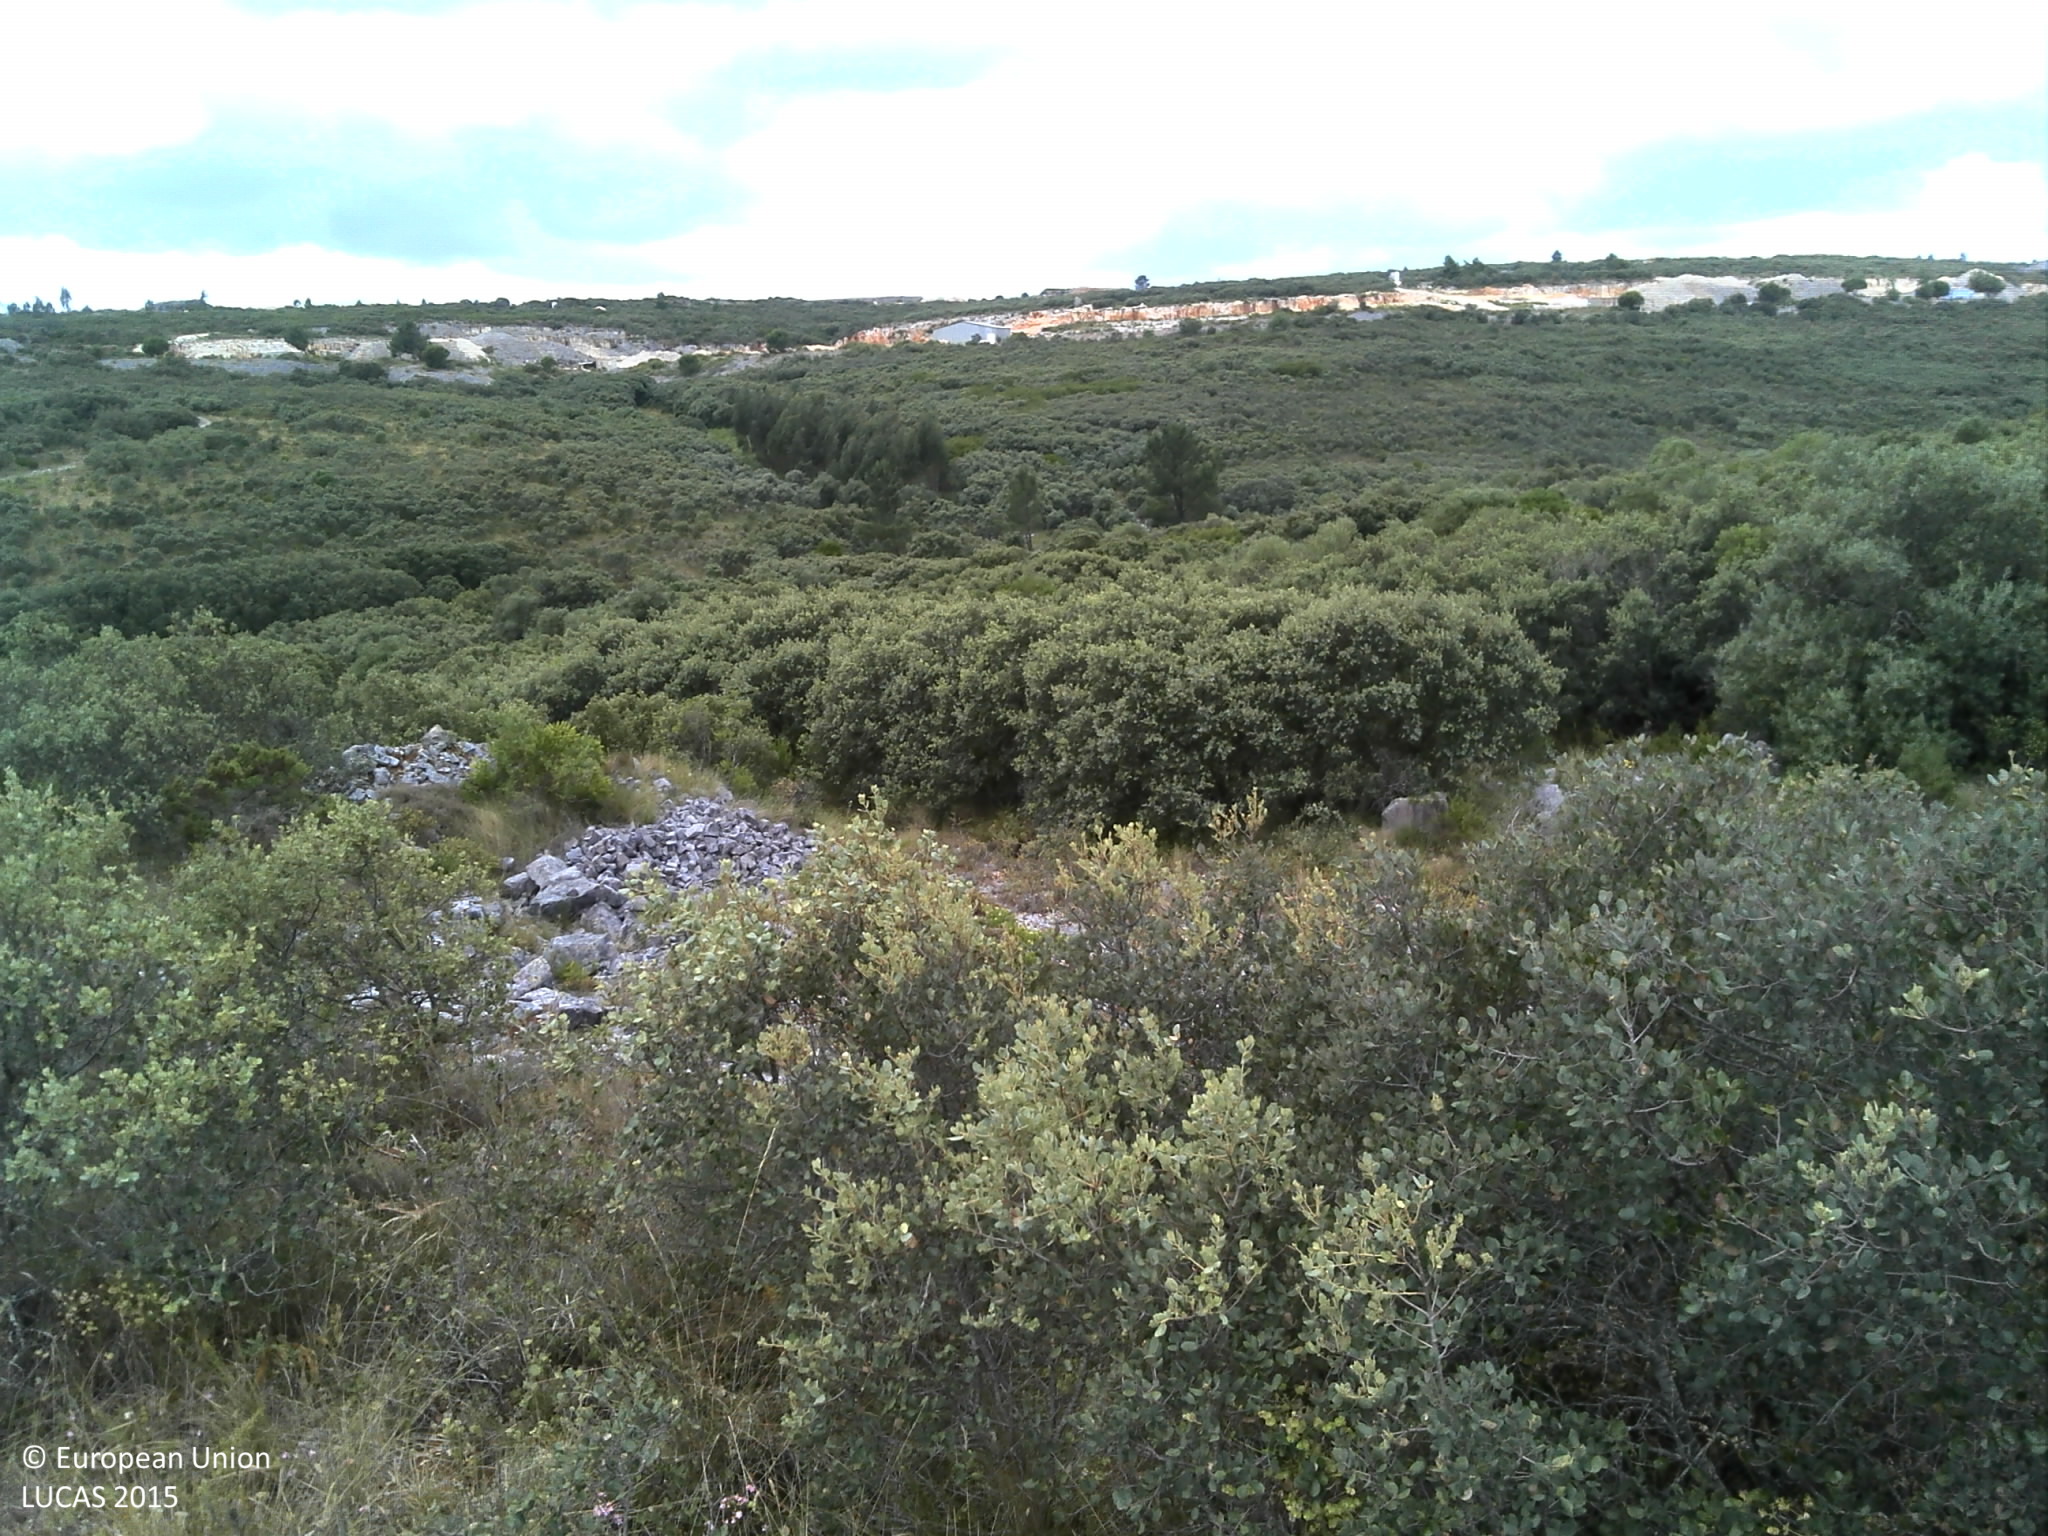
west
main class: Shrubland
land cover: Shrubland with sparse tree cover
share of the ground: 25 - 50 %
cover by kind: shrubs 50 %, unconsolidated bare surface 30 %, herbaceous plants 10 %, broadleaved forest trees 5 %, consolidated bare surface 5 %
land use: Abandoned areas
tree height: < 5 m
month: June
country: PT
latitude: 39.4671
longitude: -8.8059
